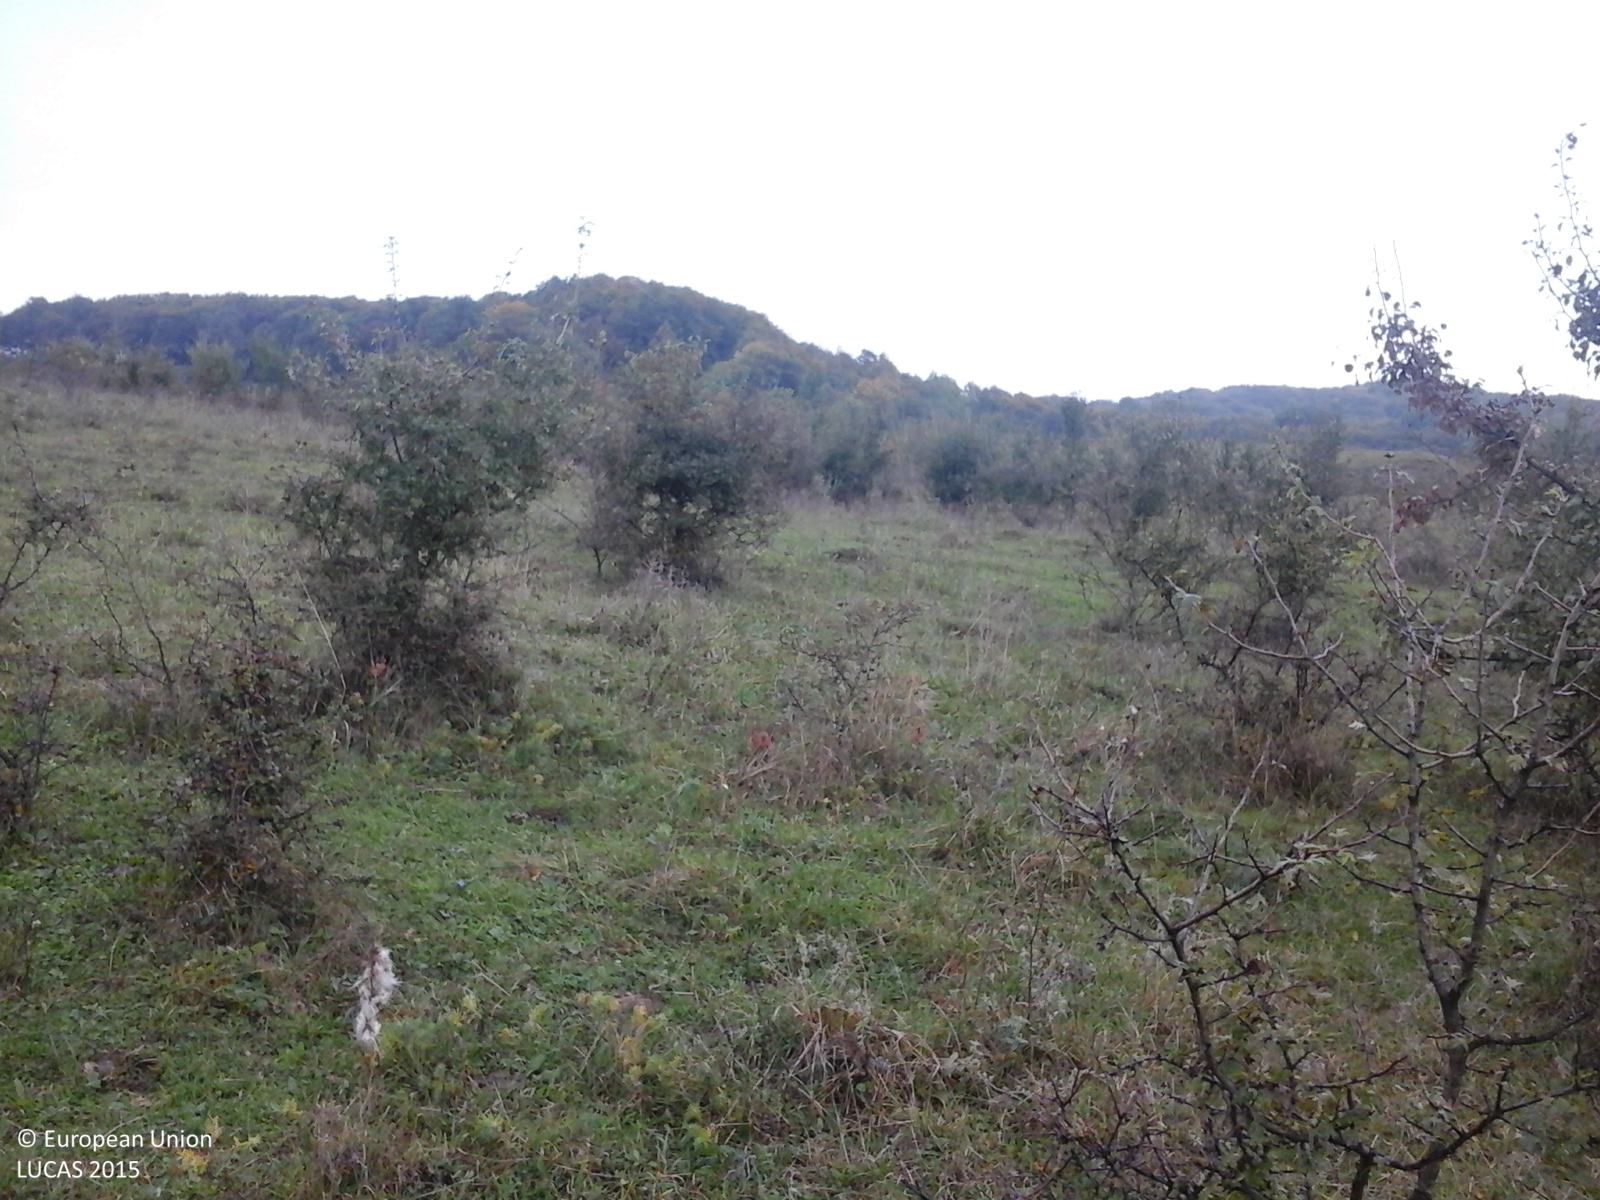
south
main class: Grassland
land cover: Grassland with sparse tree/shrub cover
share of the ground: > 75 %
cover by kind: herbaceous plants 85 %, shrubs 10 %, broadleaved forest trees 5 %
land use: Agriculture (excluding fallow land and kitchen gardens)
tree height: < 5 m
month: October
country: RO
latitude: 46.2985
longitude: 24.9599
